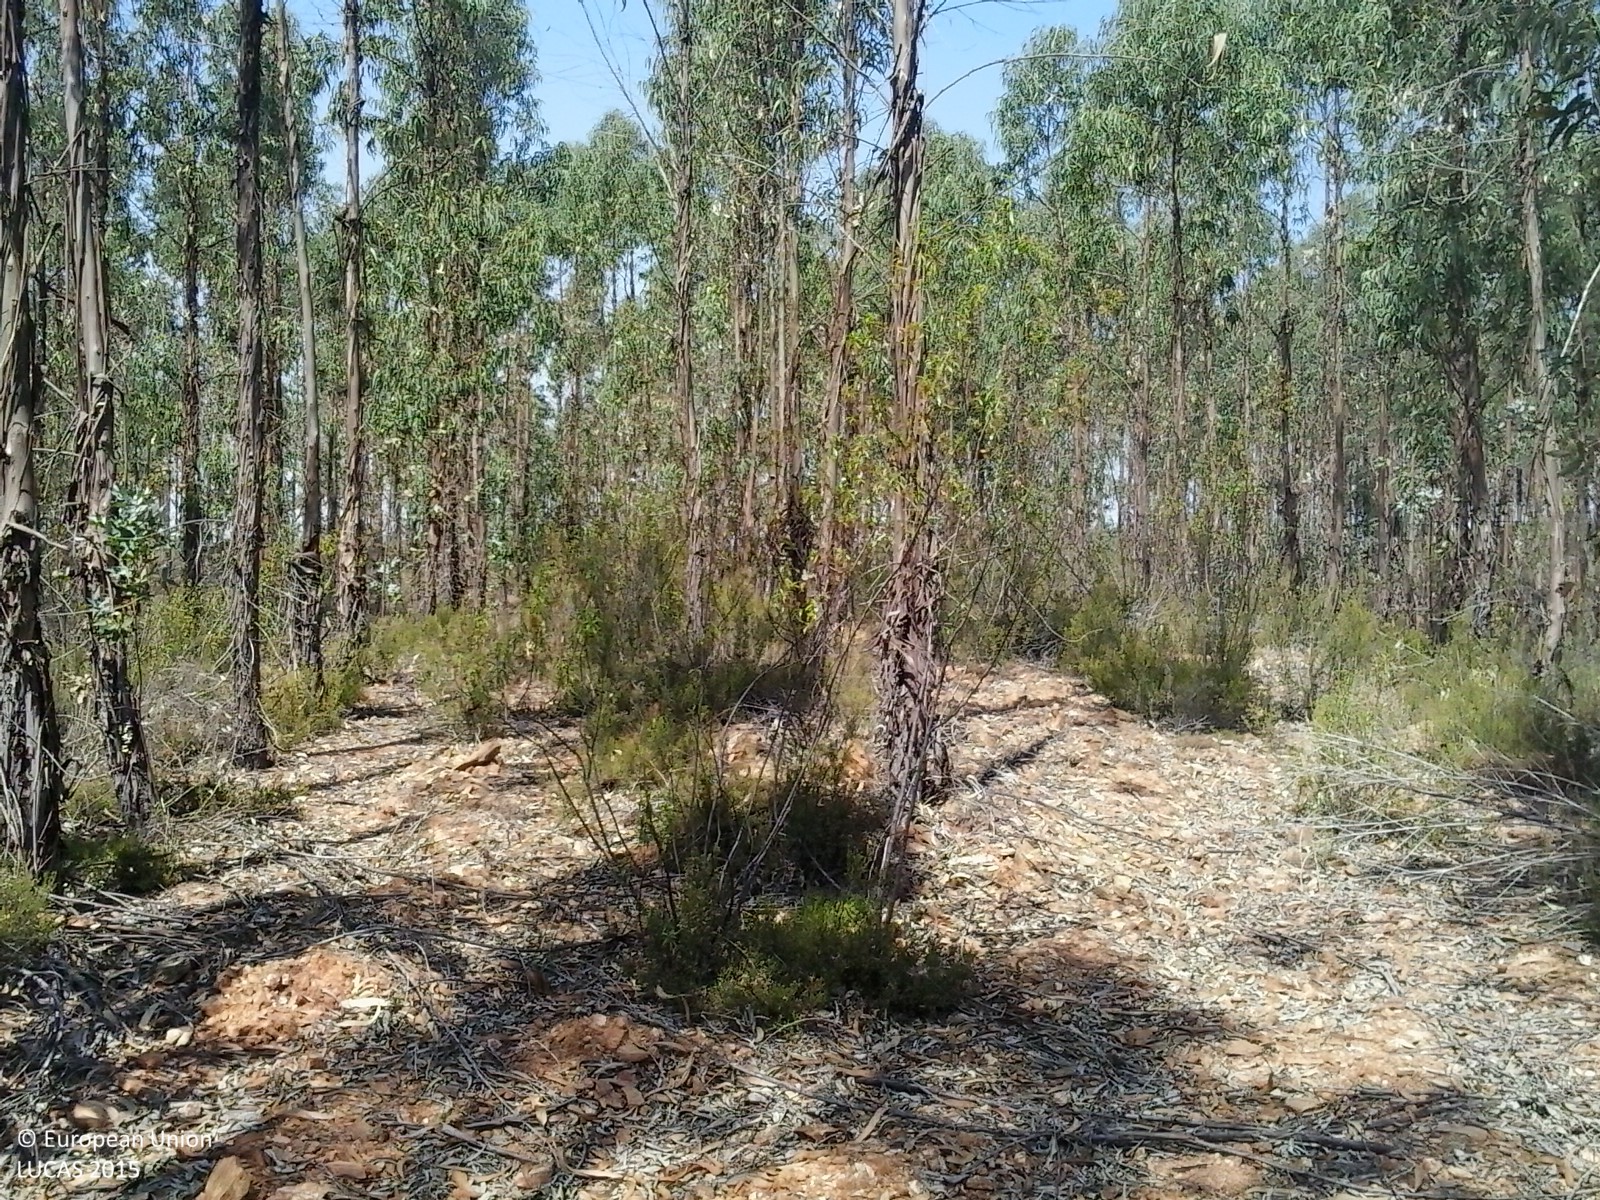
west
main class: Woodland
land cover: Broadleaved woodland
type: exotic forest
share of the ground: 25 - 50 %
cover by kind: broadleaved forest trees 45 %, shrubs 25 %, herbaceous plants 25 %, unconsolidated bare surface 5 %
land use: Forestry
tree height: > 5 m
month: July
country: ES
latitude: 37.5219
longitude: -6.4520
